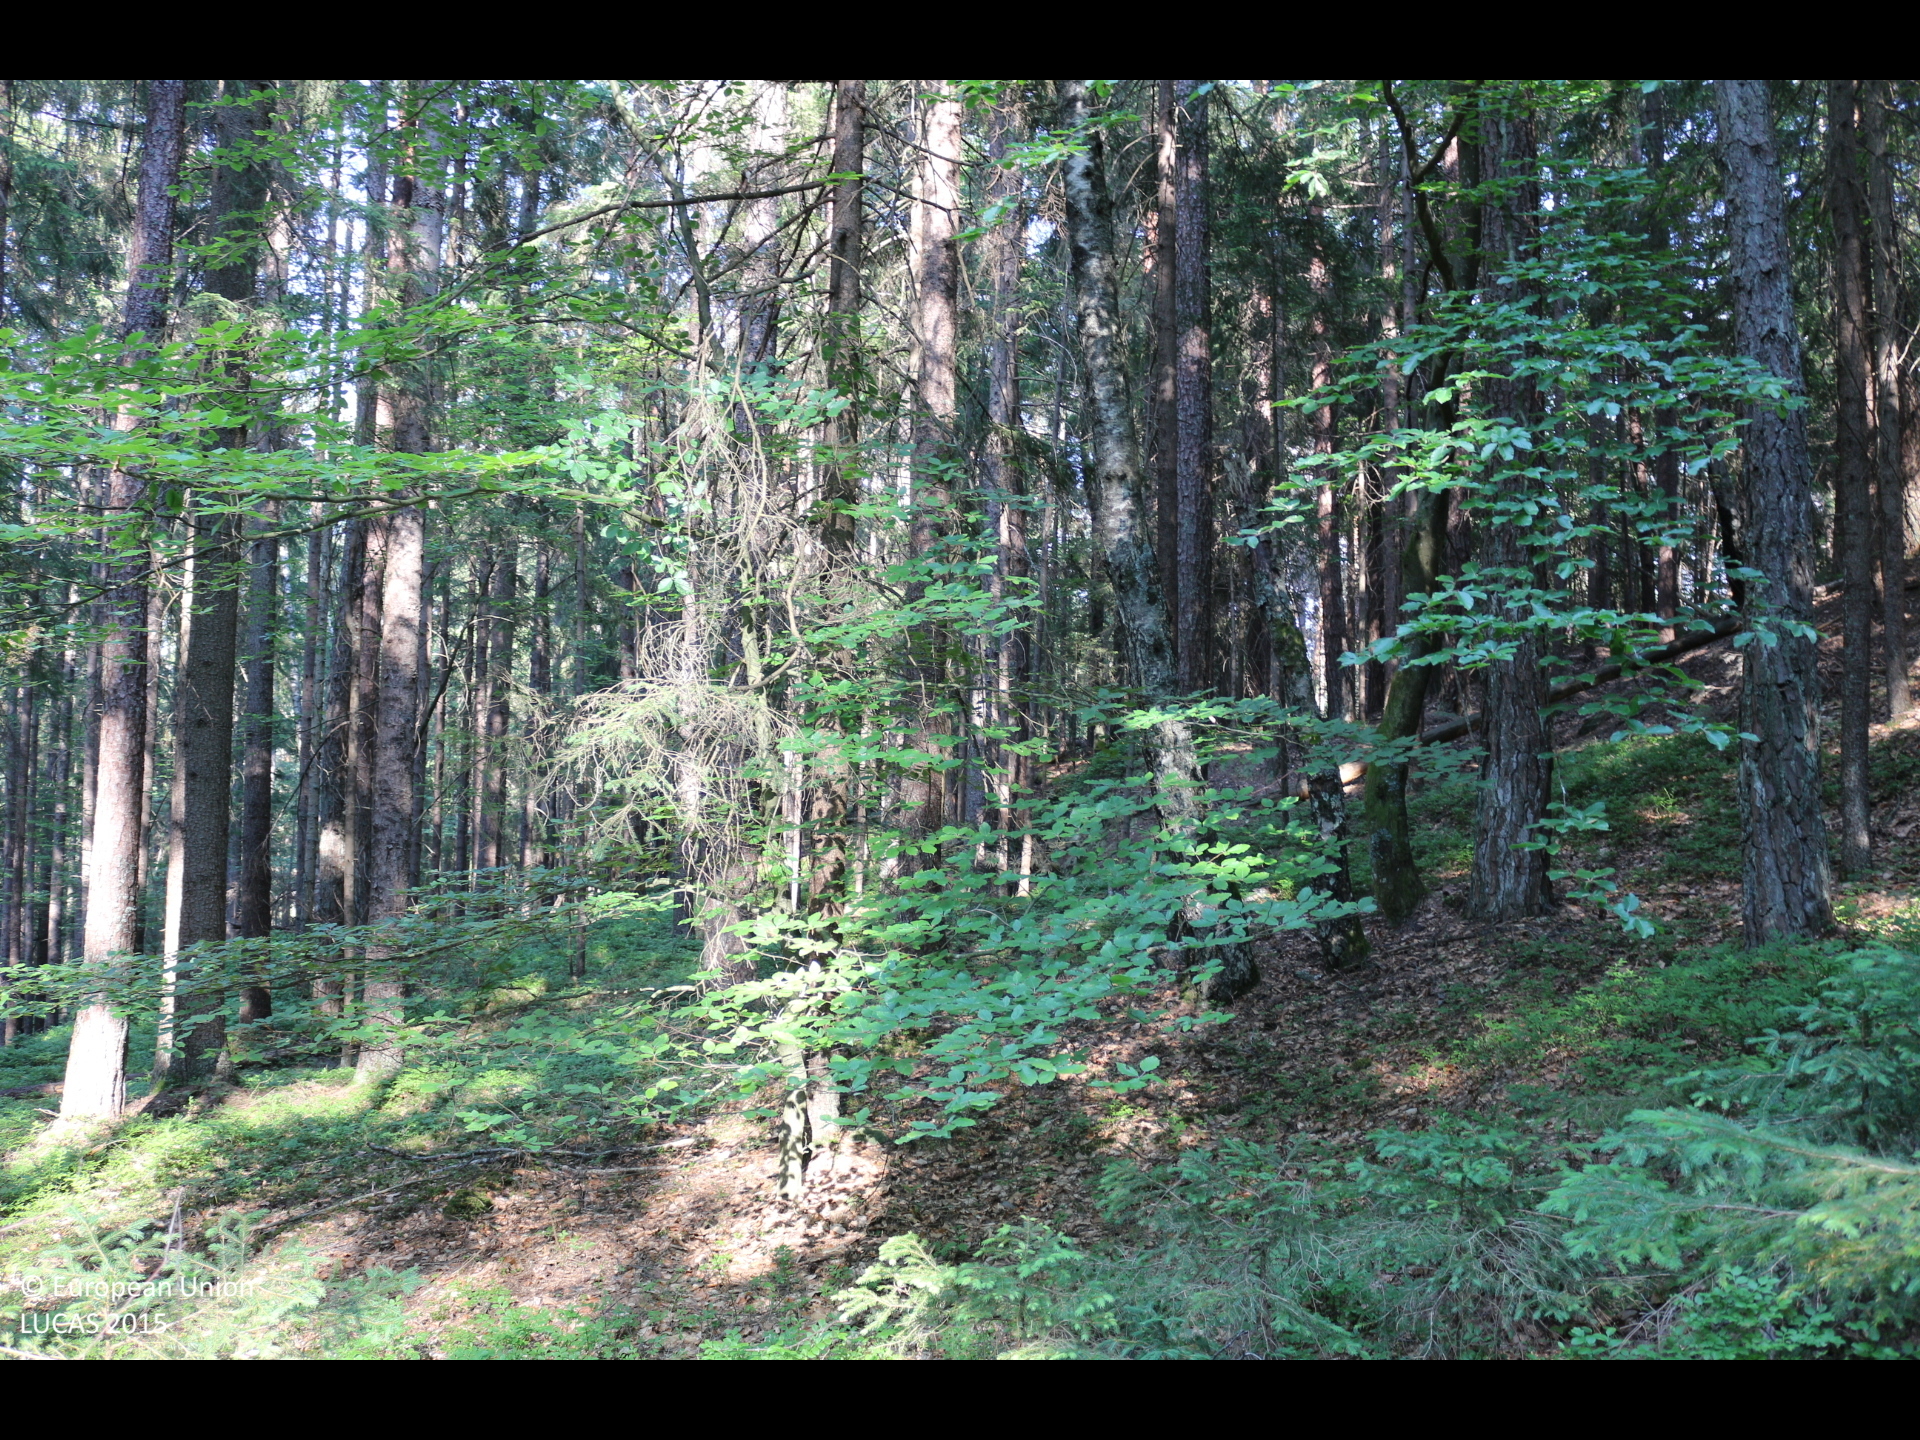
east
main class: Woodland
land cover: Other mixed woodland
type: alpine coniferous forest
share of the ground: > 75 %
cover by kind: coniferous forest trees 70 %, broadleaved forest trees 25 %, herbaceous plants 5 %
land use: Forestry
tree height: > 5 m
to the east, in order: Other mixed woodland; Pine dominated mixed woodland; Pine dominated coniferous woodland; Pine dominated mixed woodland; Other mixed woodland
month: June
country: AT
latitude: 46.6368
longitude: 14.0076
